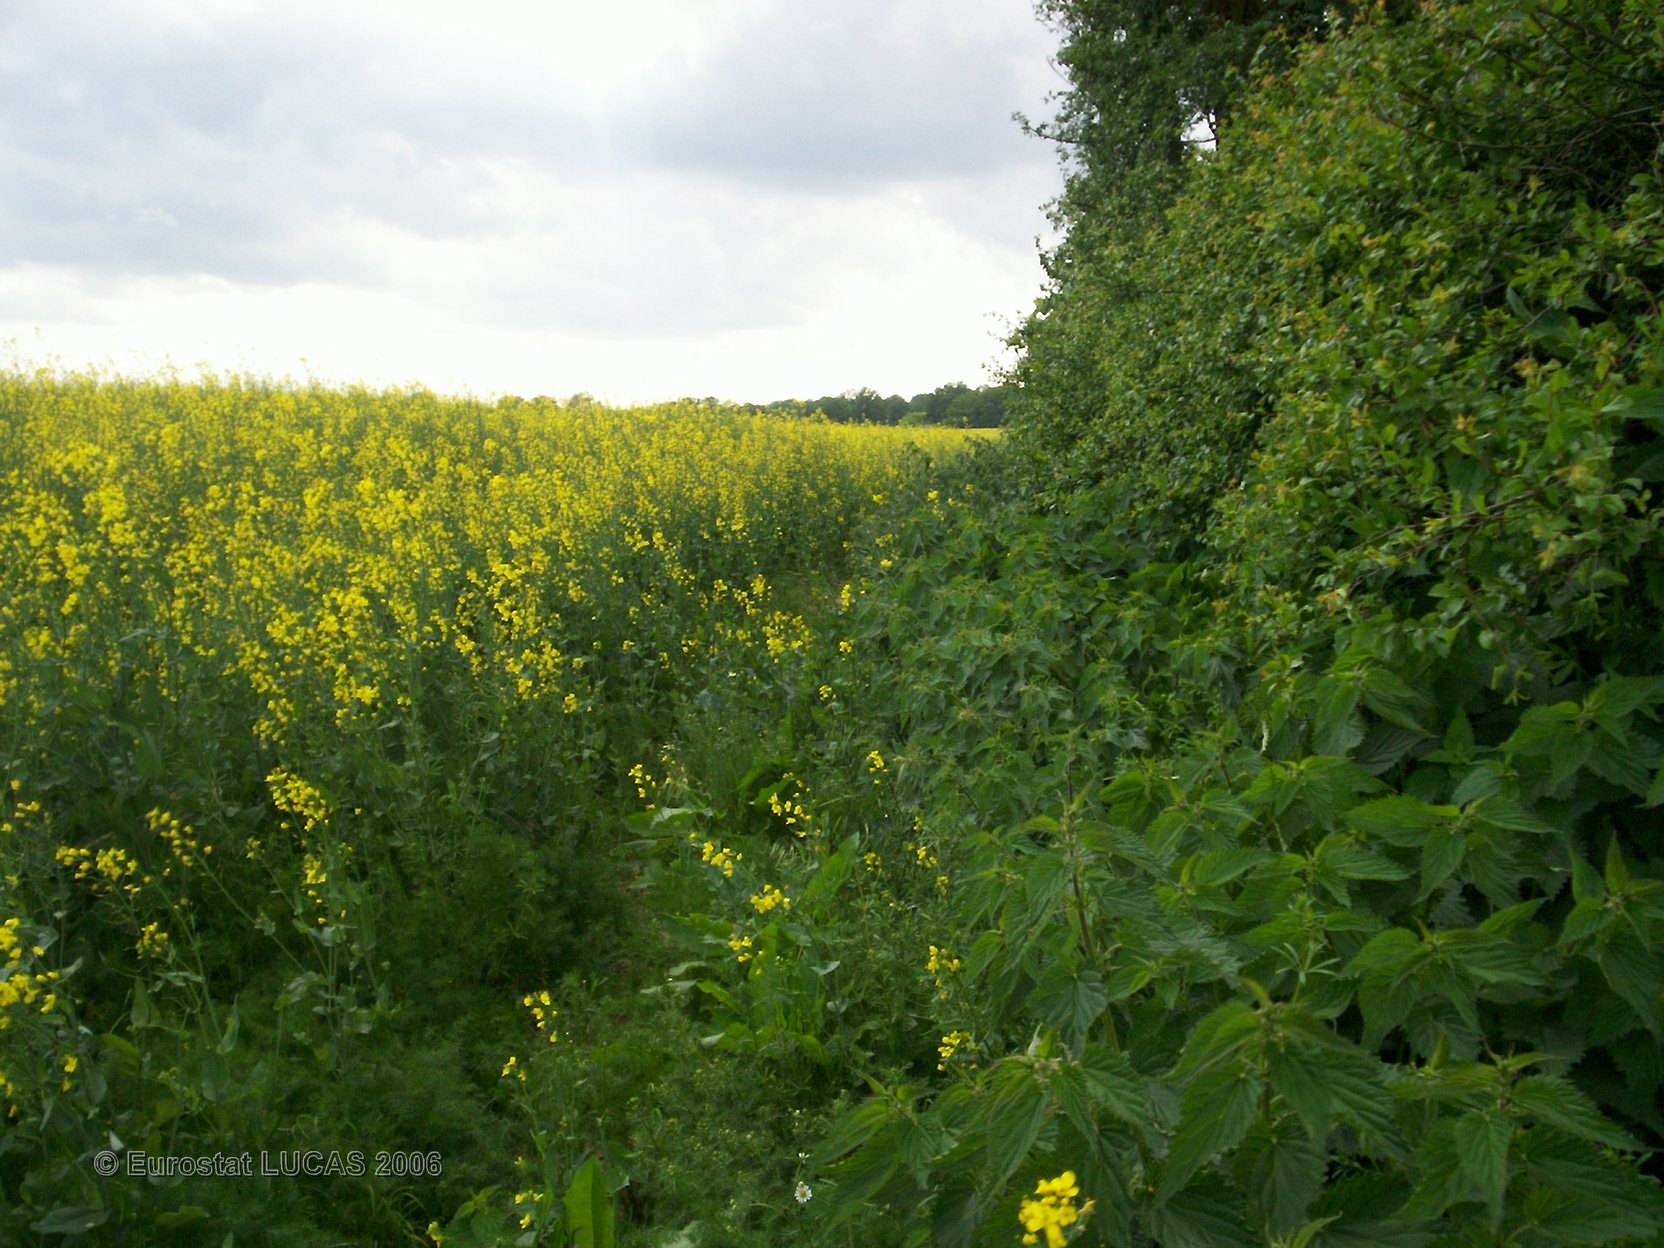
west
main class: Cropland
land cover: Rape and turnip rape
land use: Agriculture (excluding fallow land and kitchen gardens)
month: May
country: FR
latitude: 48.7625
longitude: 2.7665
